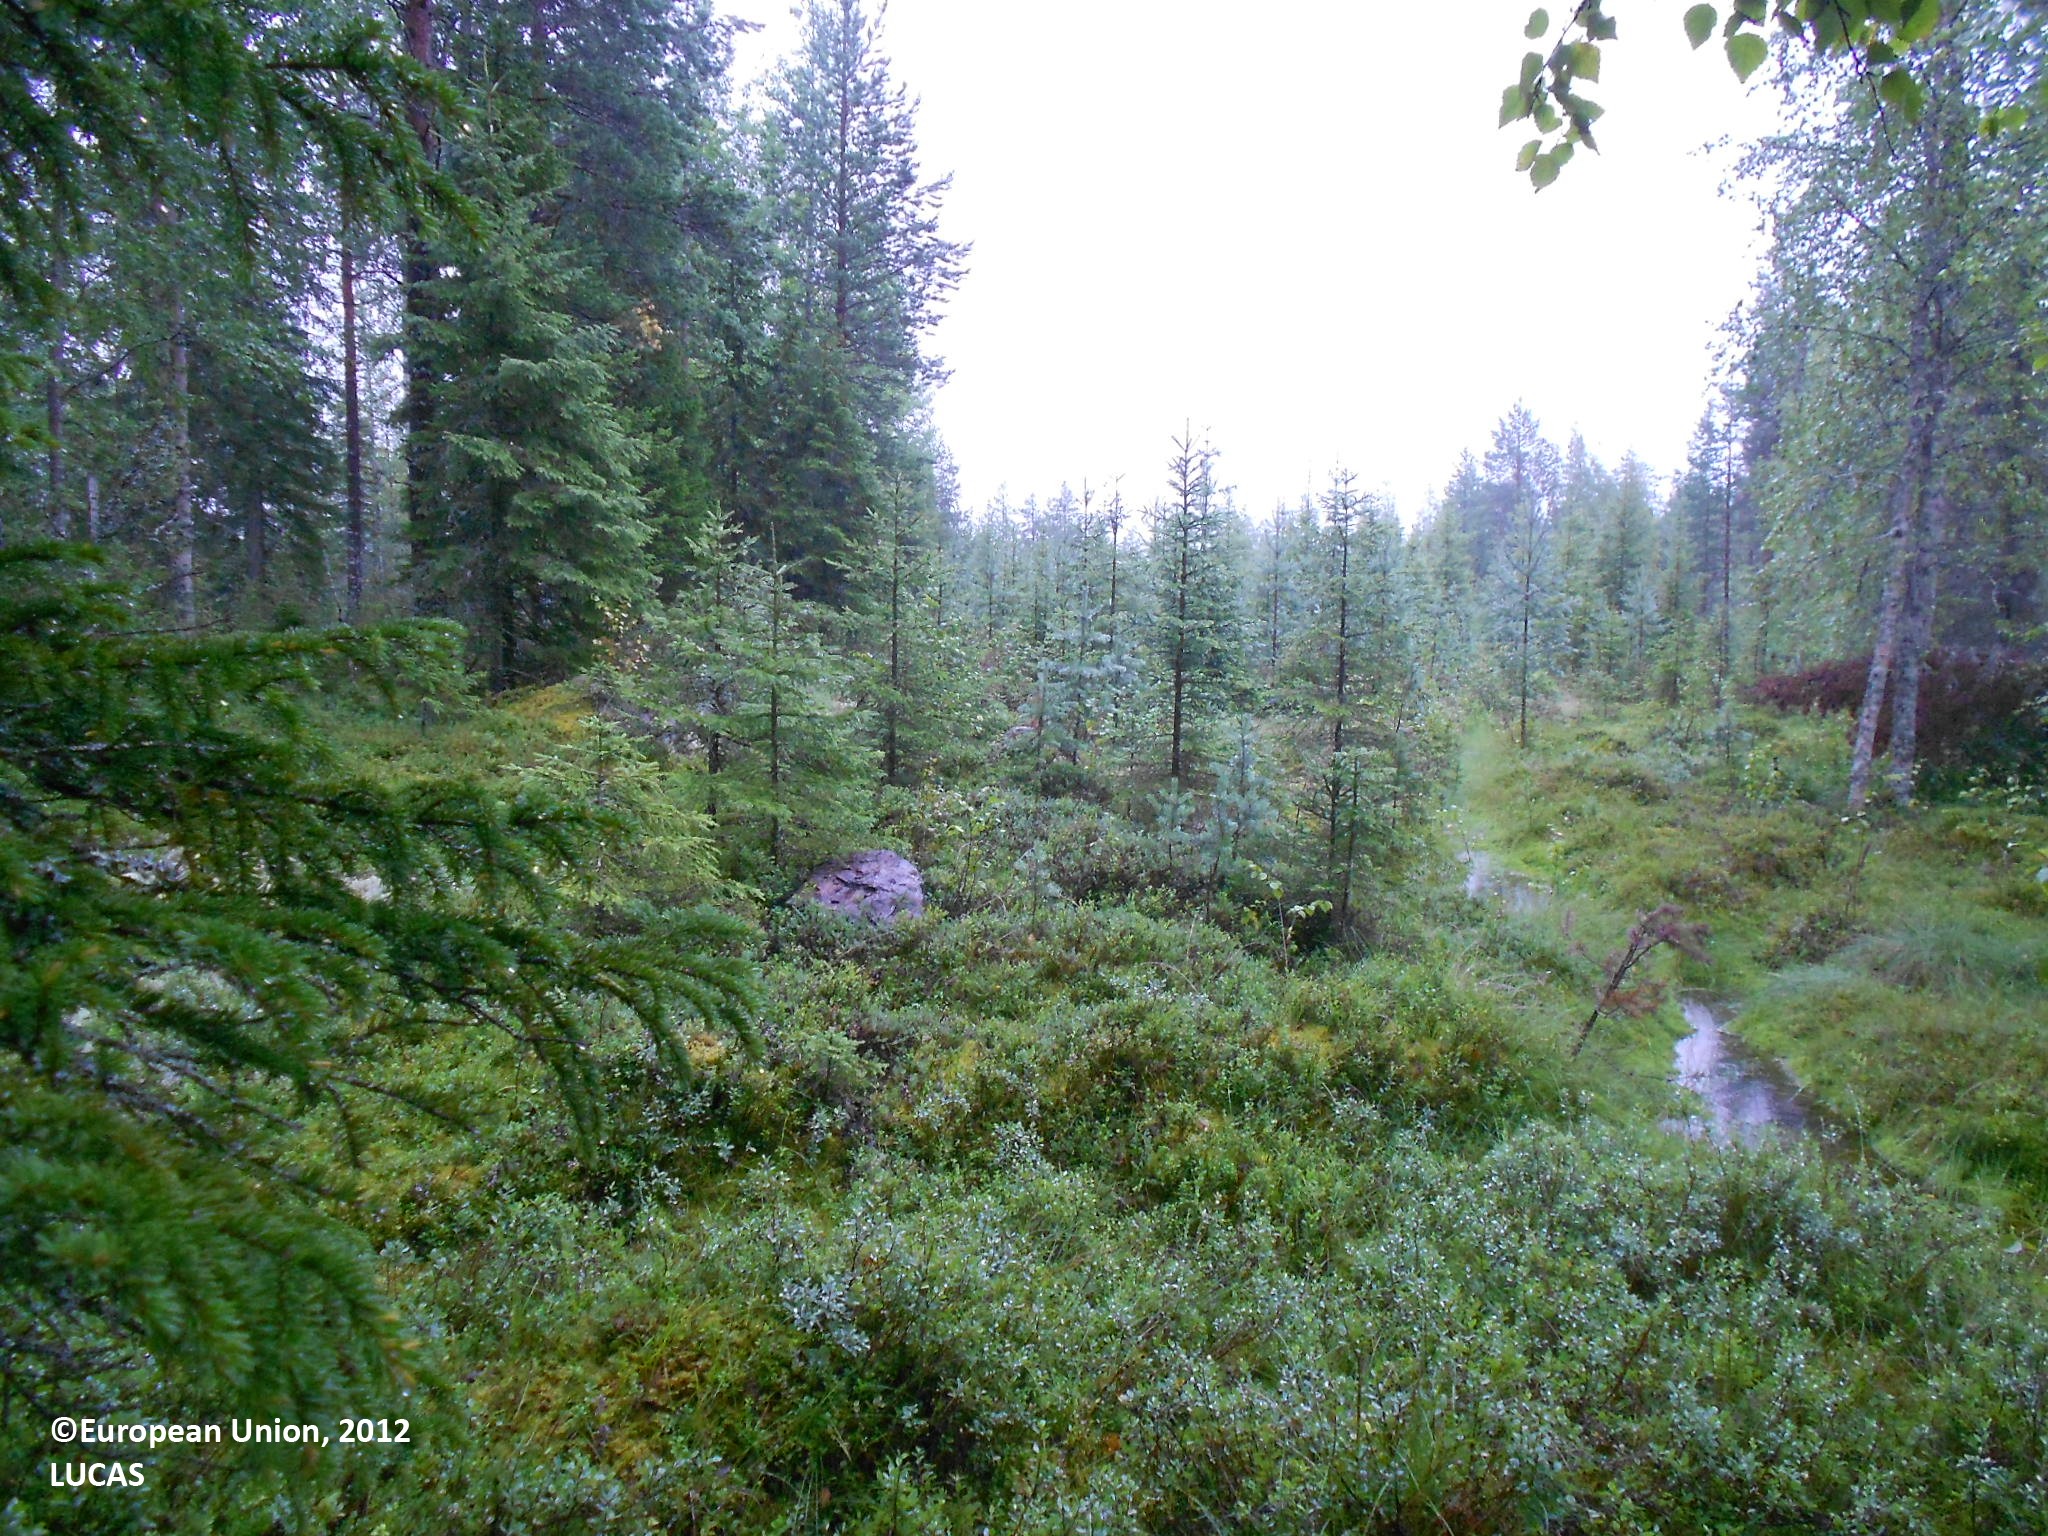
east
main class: Woodland
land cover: Pine dominated mixed woodland
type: boreal forest
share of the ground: 50 - 75 %
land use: Forestry
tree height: > 5 m
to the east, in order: Pine dominated mixed woodland; Ditches and canals; Pine dominated coniferous woodland; Electric lines; Pine dominated coniferous woodland; Ditches and canals; Pine dominated coniferous woodland; Ditches and canals; Pine dominated coniferous woodland; Other coniferous woodland
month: August
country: FI
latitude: 63.9250
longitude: 28.2203
